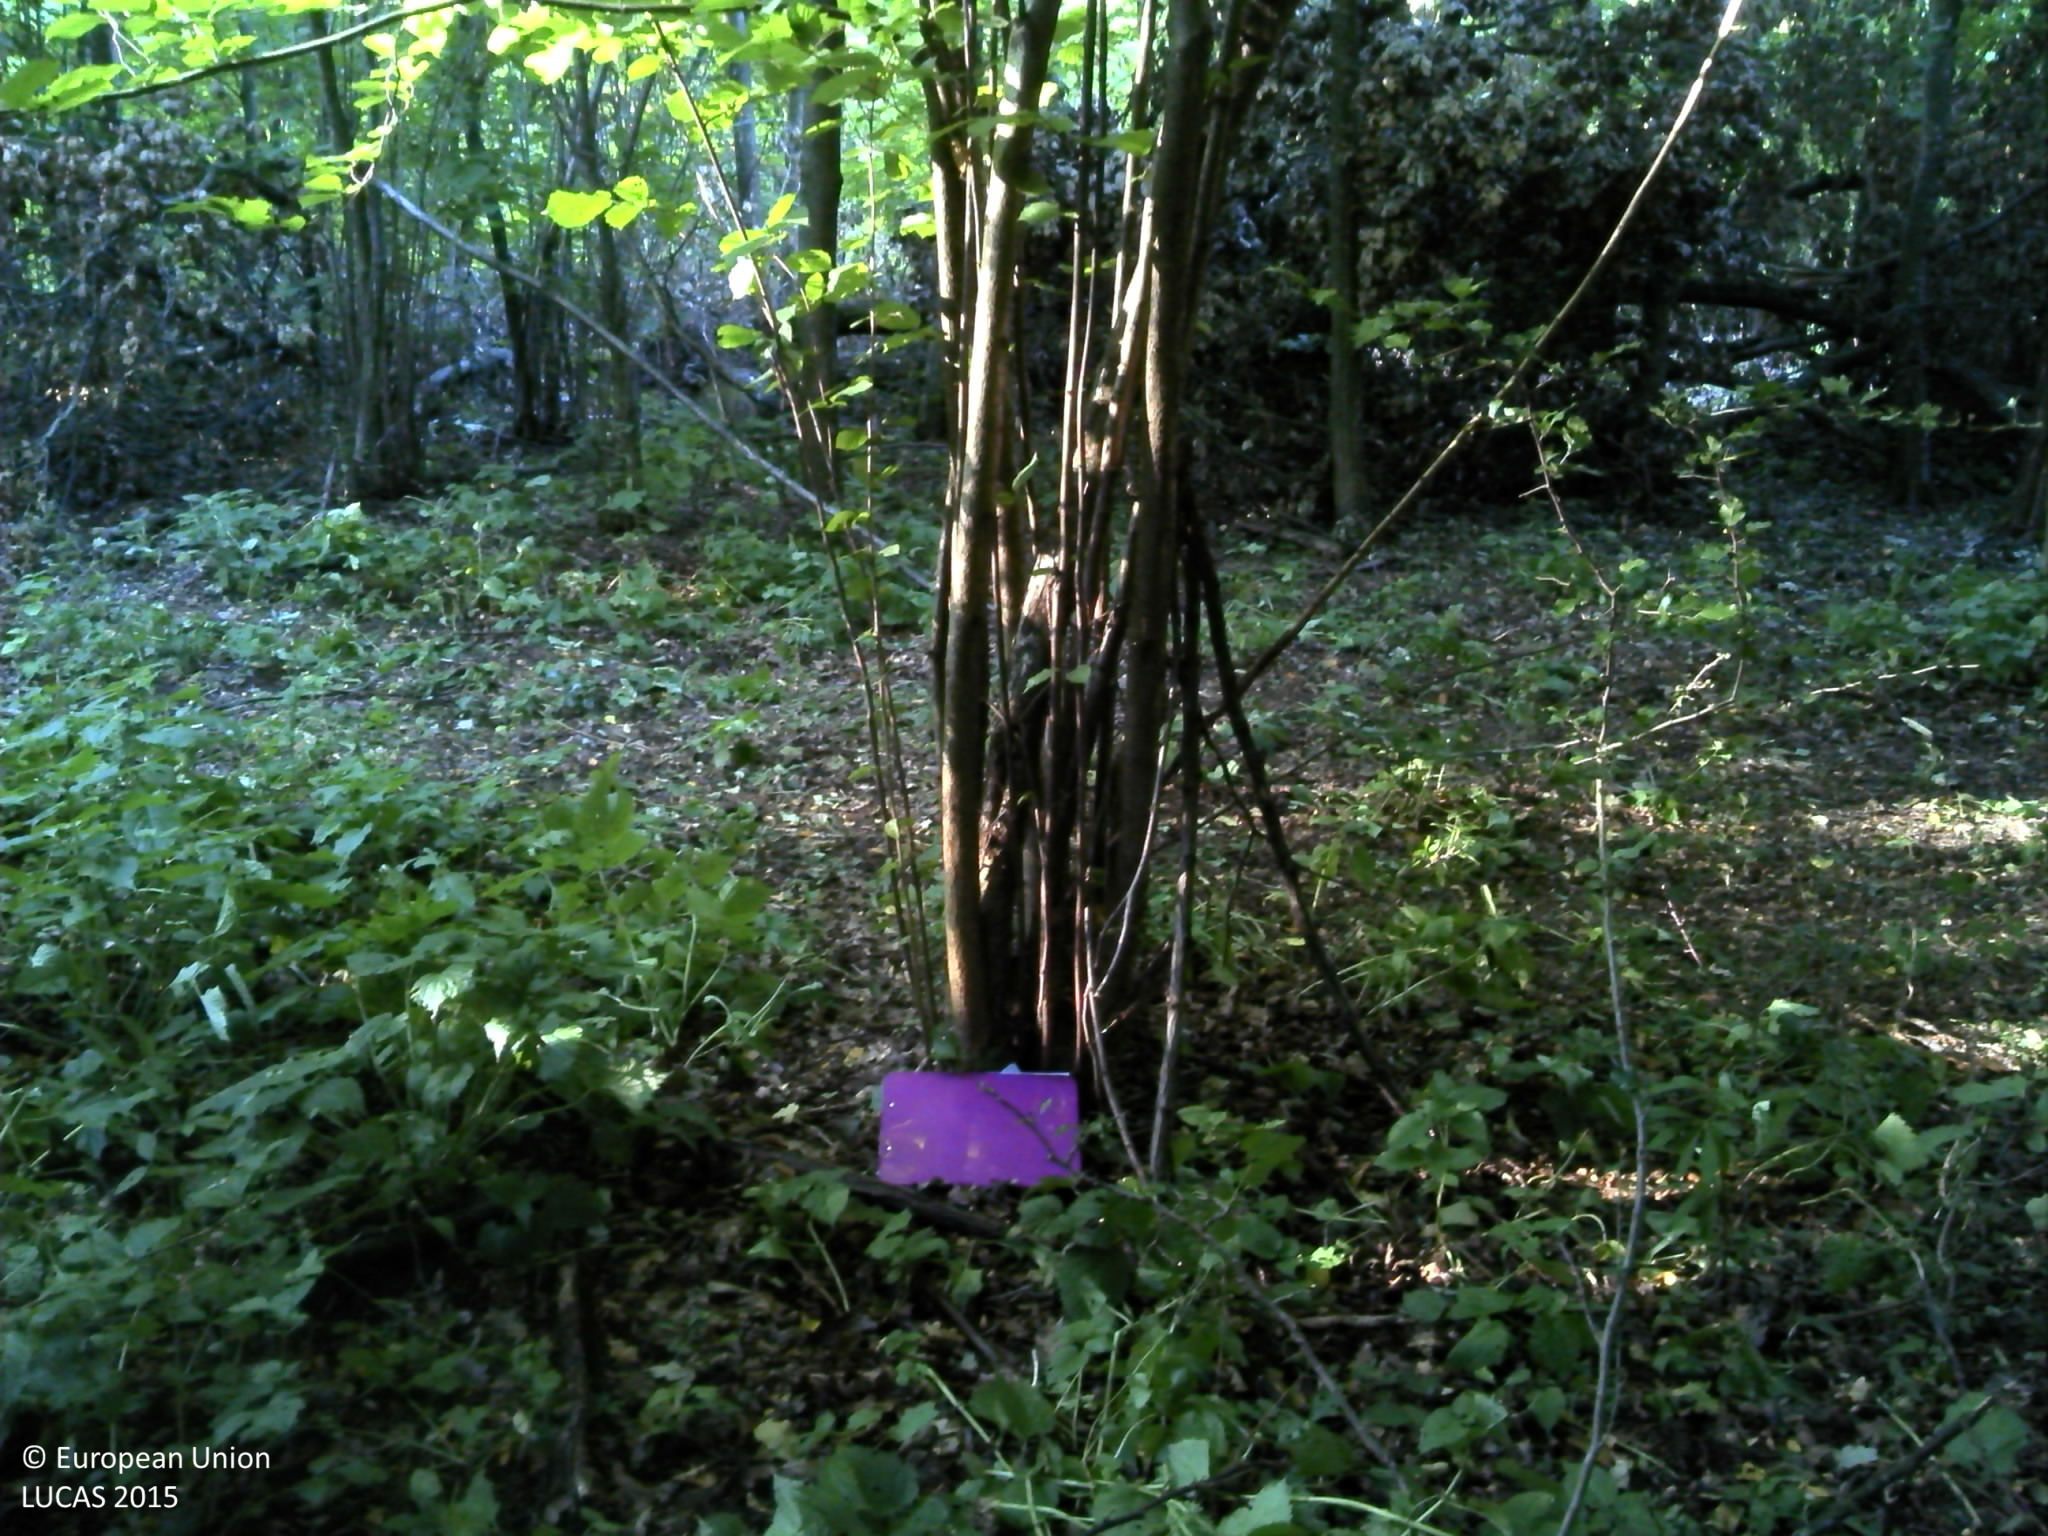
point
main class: Woodland
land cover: Broadleaved woodland
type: acidophilous oak and oak-birch forest
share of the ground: > 75 %
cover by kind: broadleaved forest trees 90 %, shrubs 5 %, herbaceous plants 5 %
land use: Forestry
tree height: > 5 m
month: July
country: HR
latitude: 45.9915
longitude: 16.7785
